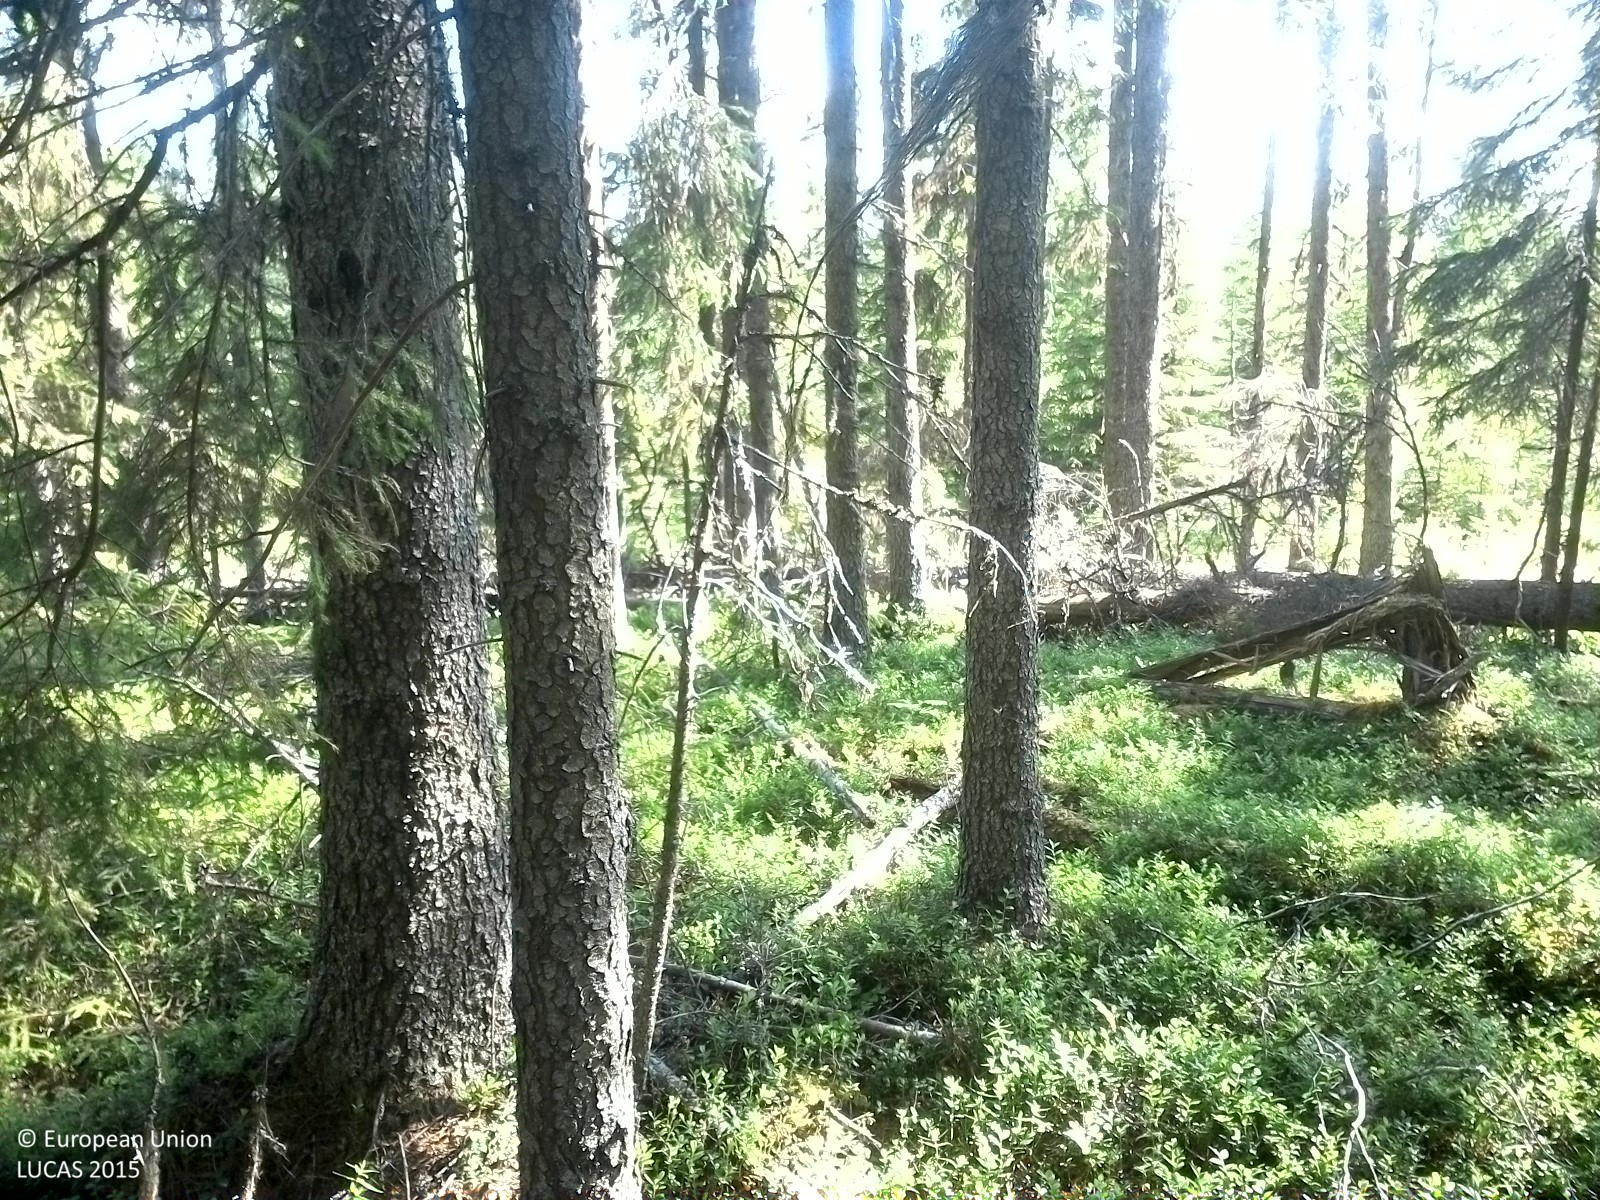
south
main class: Woodland
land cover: Spruce dominated coniferous woodland
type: boreal forest
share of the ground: > 75 %
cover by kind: coniferous forest trees 80 %, shrubs 20 %
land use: Forestry
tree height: > 5 m
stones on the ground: < 10 %
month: July
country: SE
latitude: 63.6267
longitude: 15.1609
